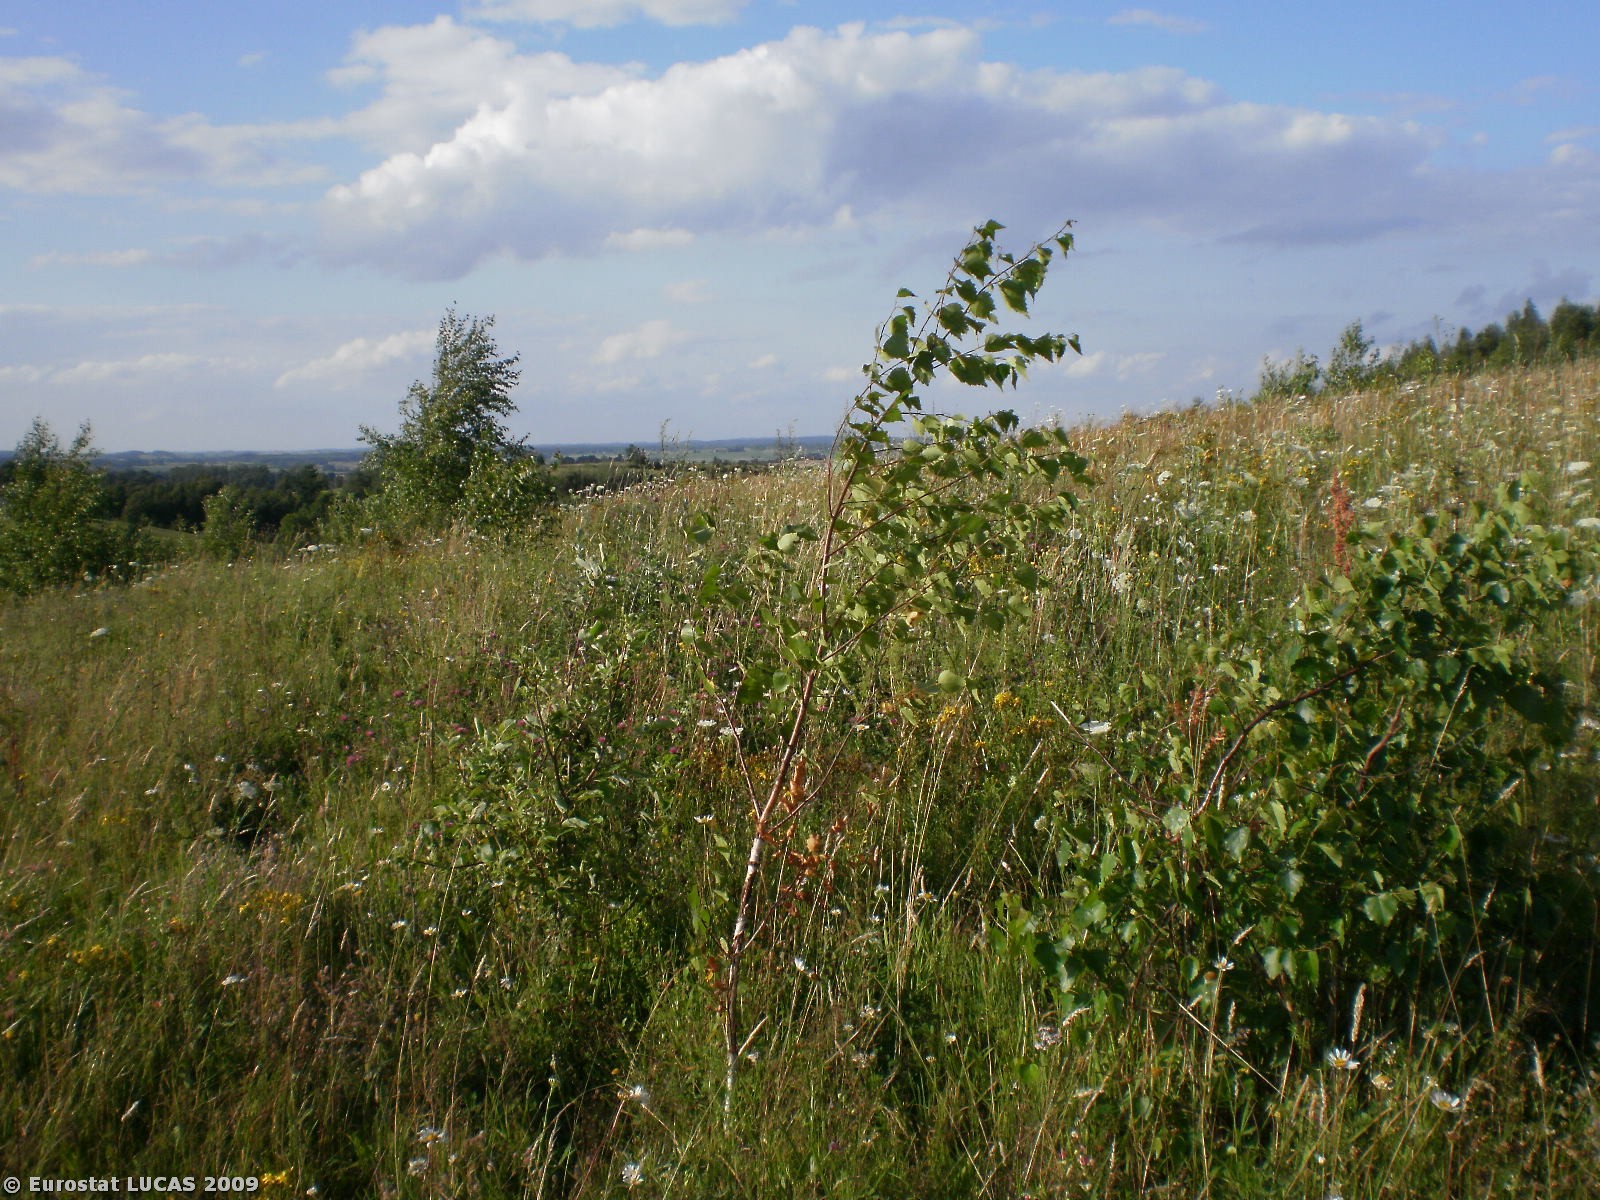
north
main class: Grassland
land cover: Grassland with sparse tree/shrub cover
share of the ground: > 75 %
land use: Unused
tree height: > 5 m
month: July
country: PL
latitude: 53.9691
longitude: 20.6021
